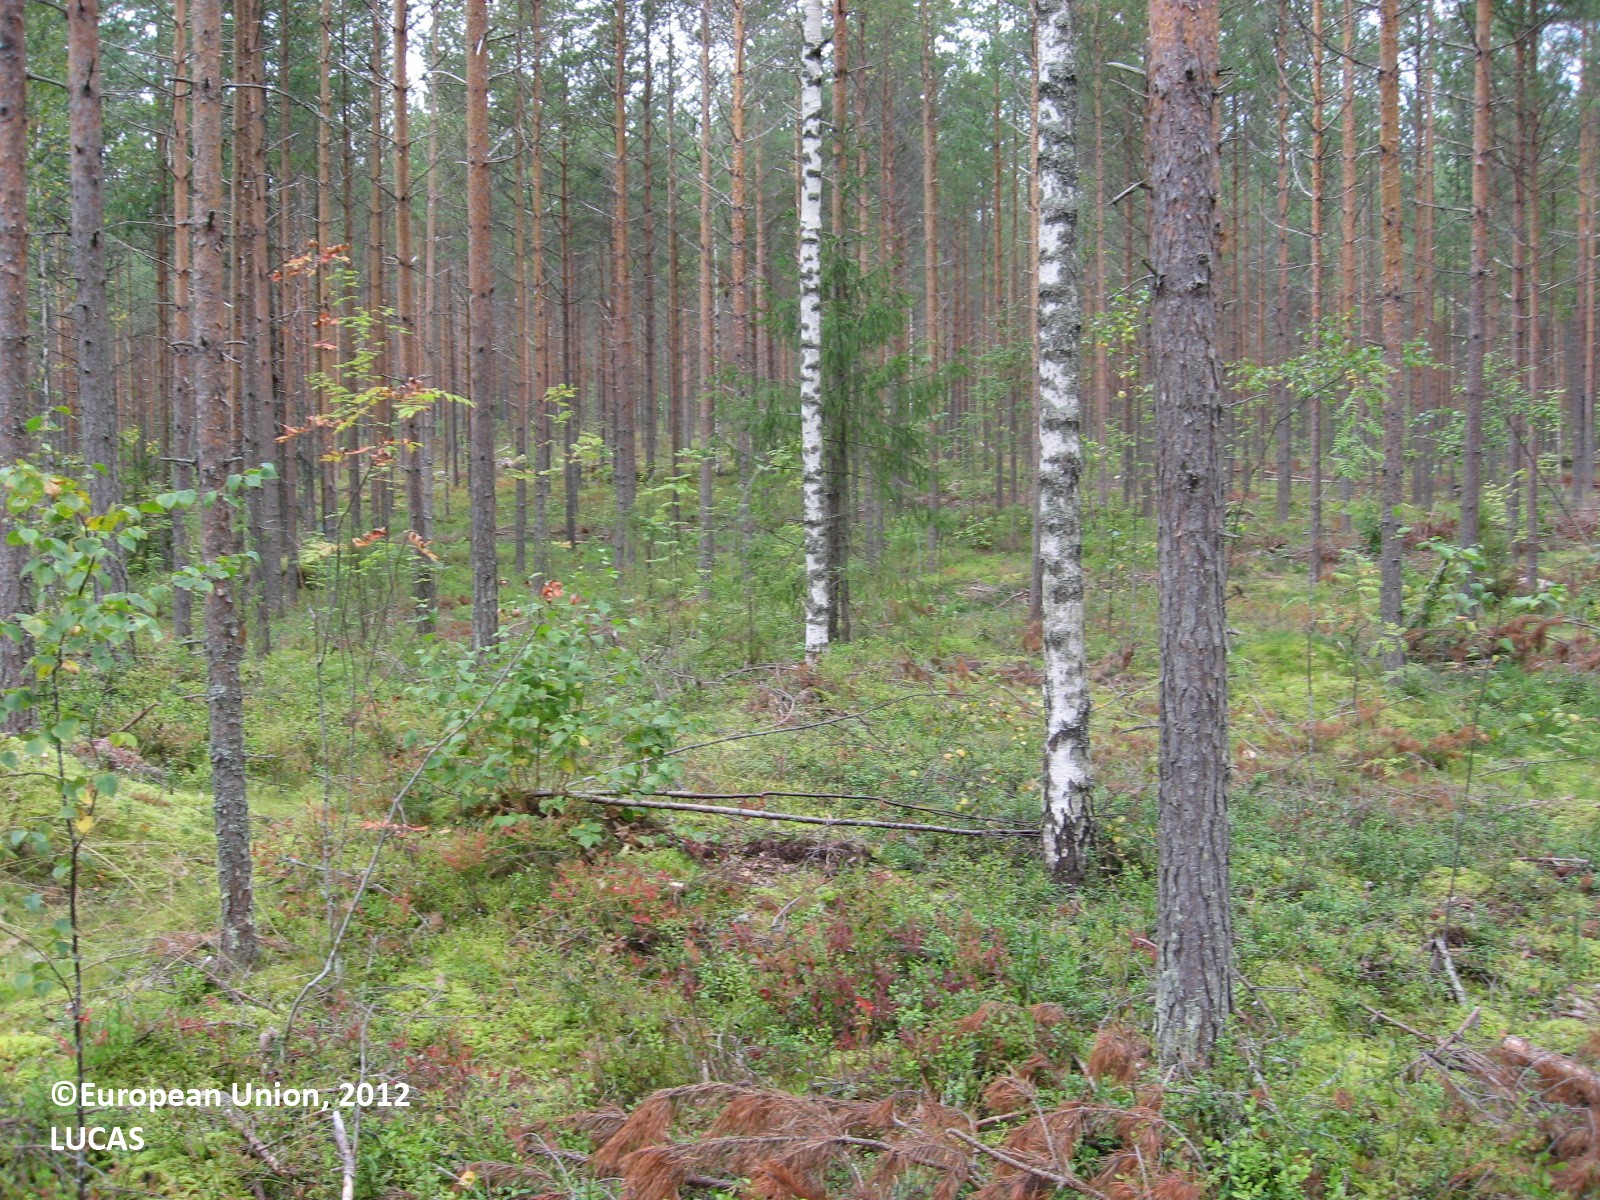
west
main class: Woodland
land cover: Pine dominated mixed woodland
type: boreal forest
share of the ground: 50 - 75 %
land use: Forestry
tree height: > 5 m
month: September
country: FI
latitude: 61.1268
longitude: 26.4302
